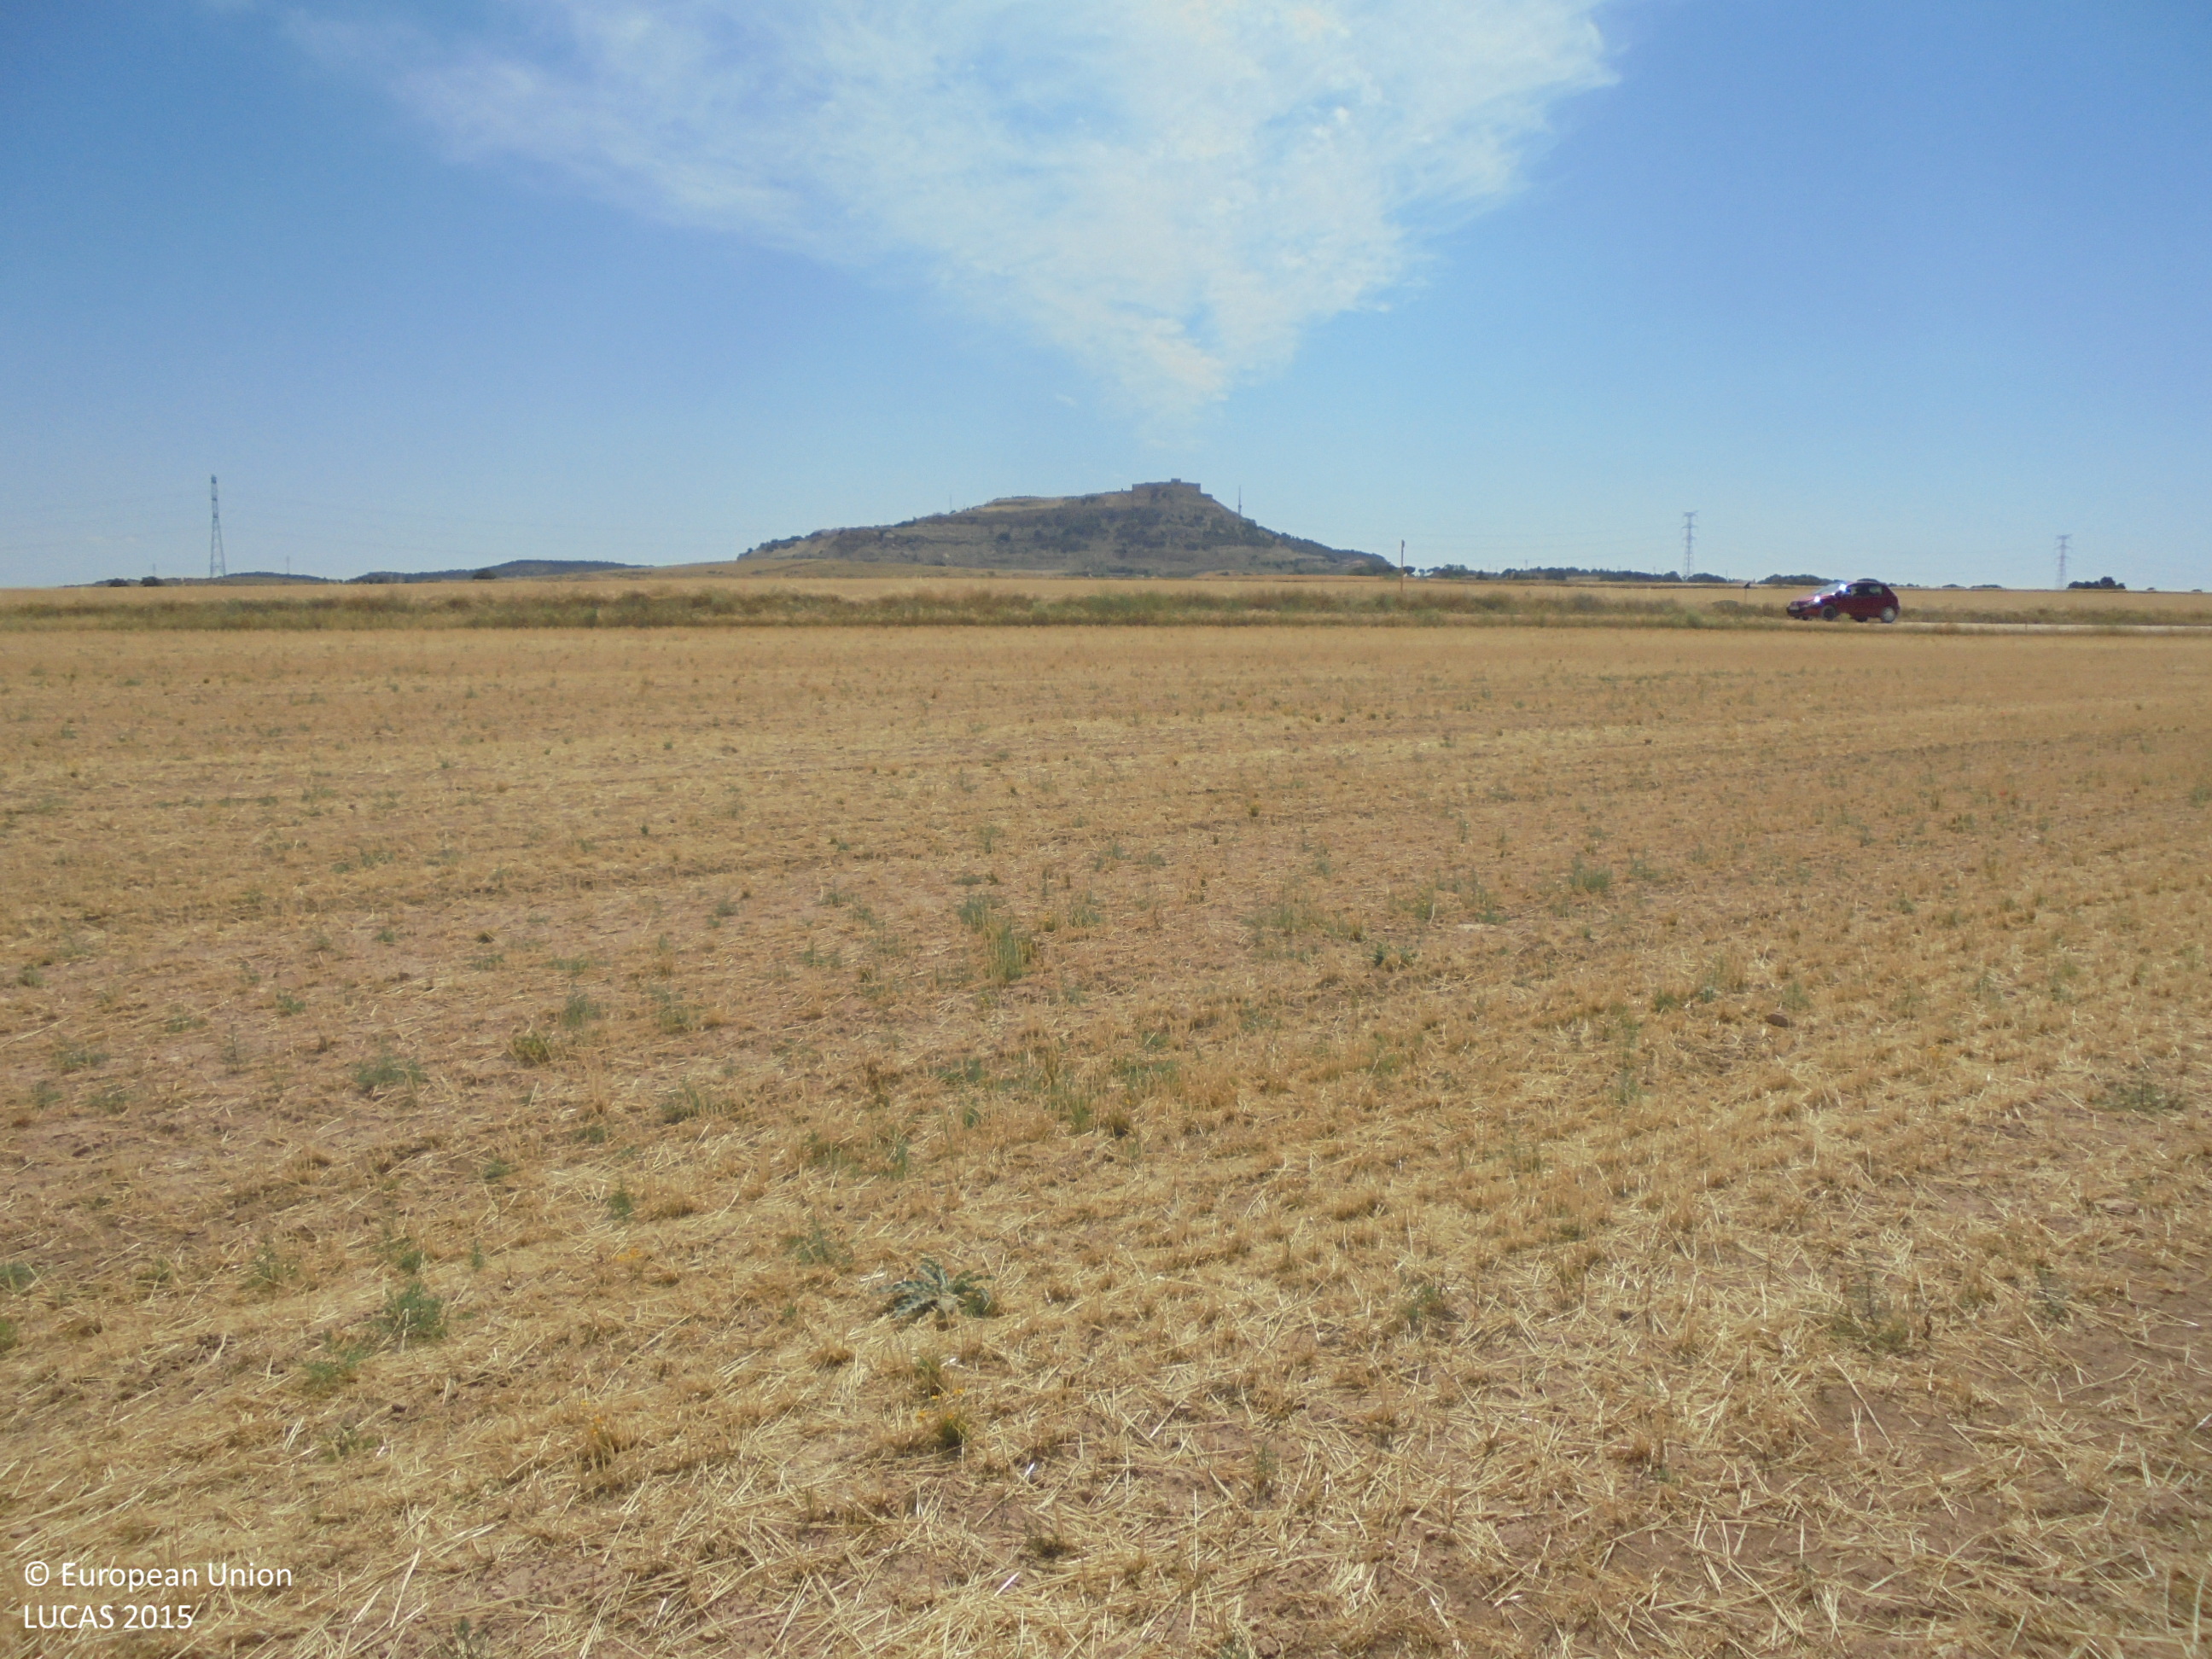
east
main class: Cropland
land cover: Barley
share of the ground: < 10 %
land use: Agriculture (excluding fallow land and kitchen gardens)
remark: Harvested field
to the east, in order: Barley; Grass margins; Tracks; Grass margins; Barley
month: June
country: ES
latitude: 38.9189
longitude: -1.7514
